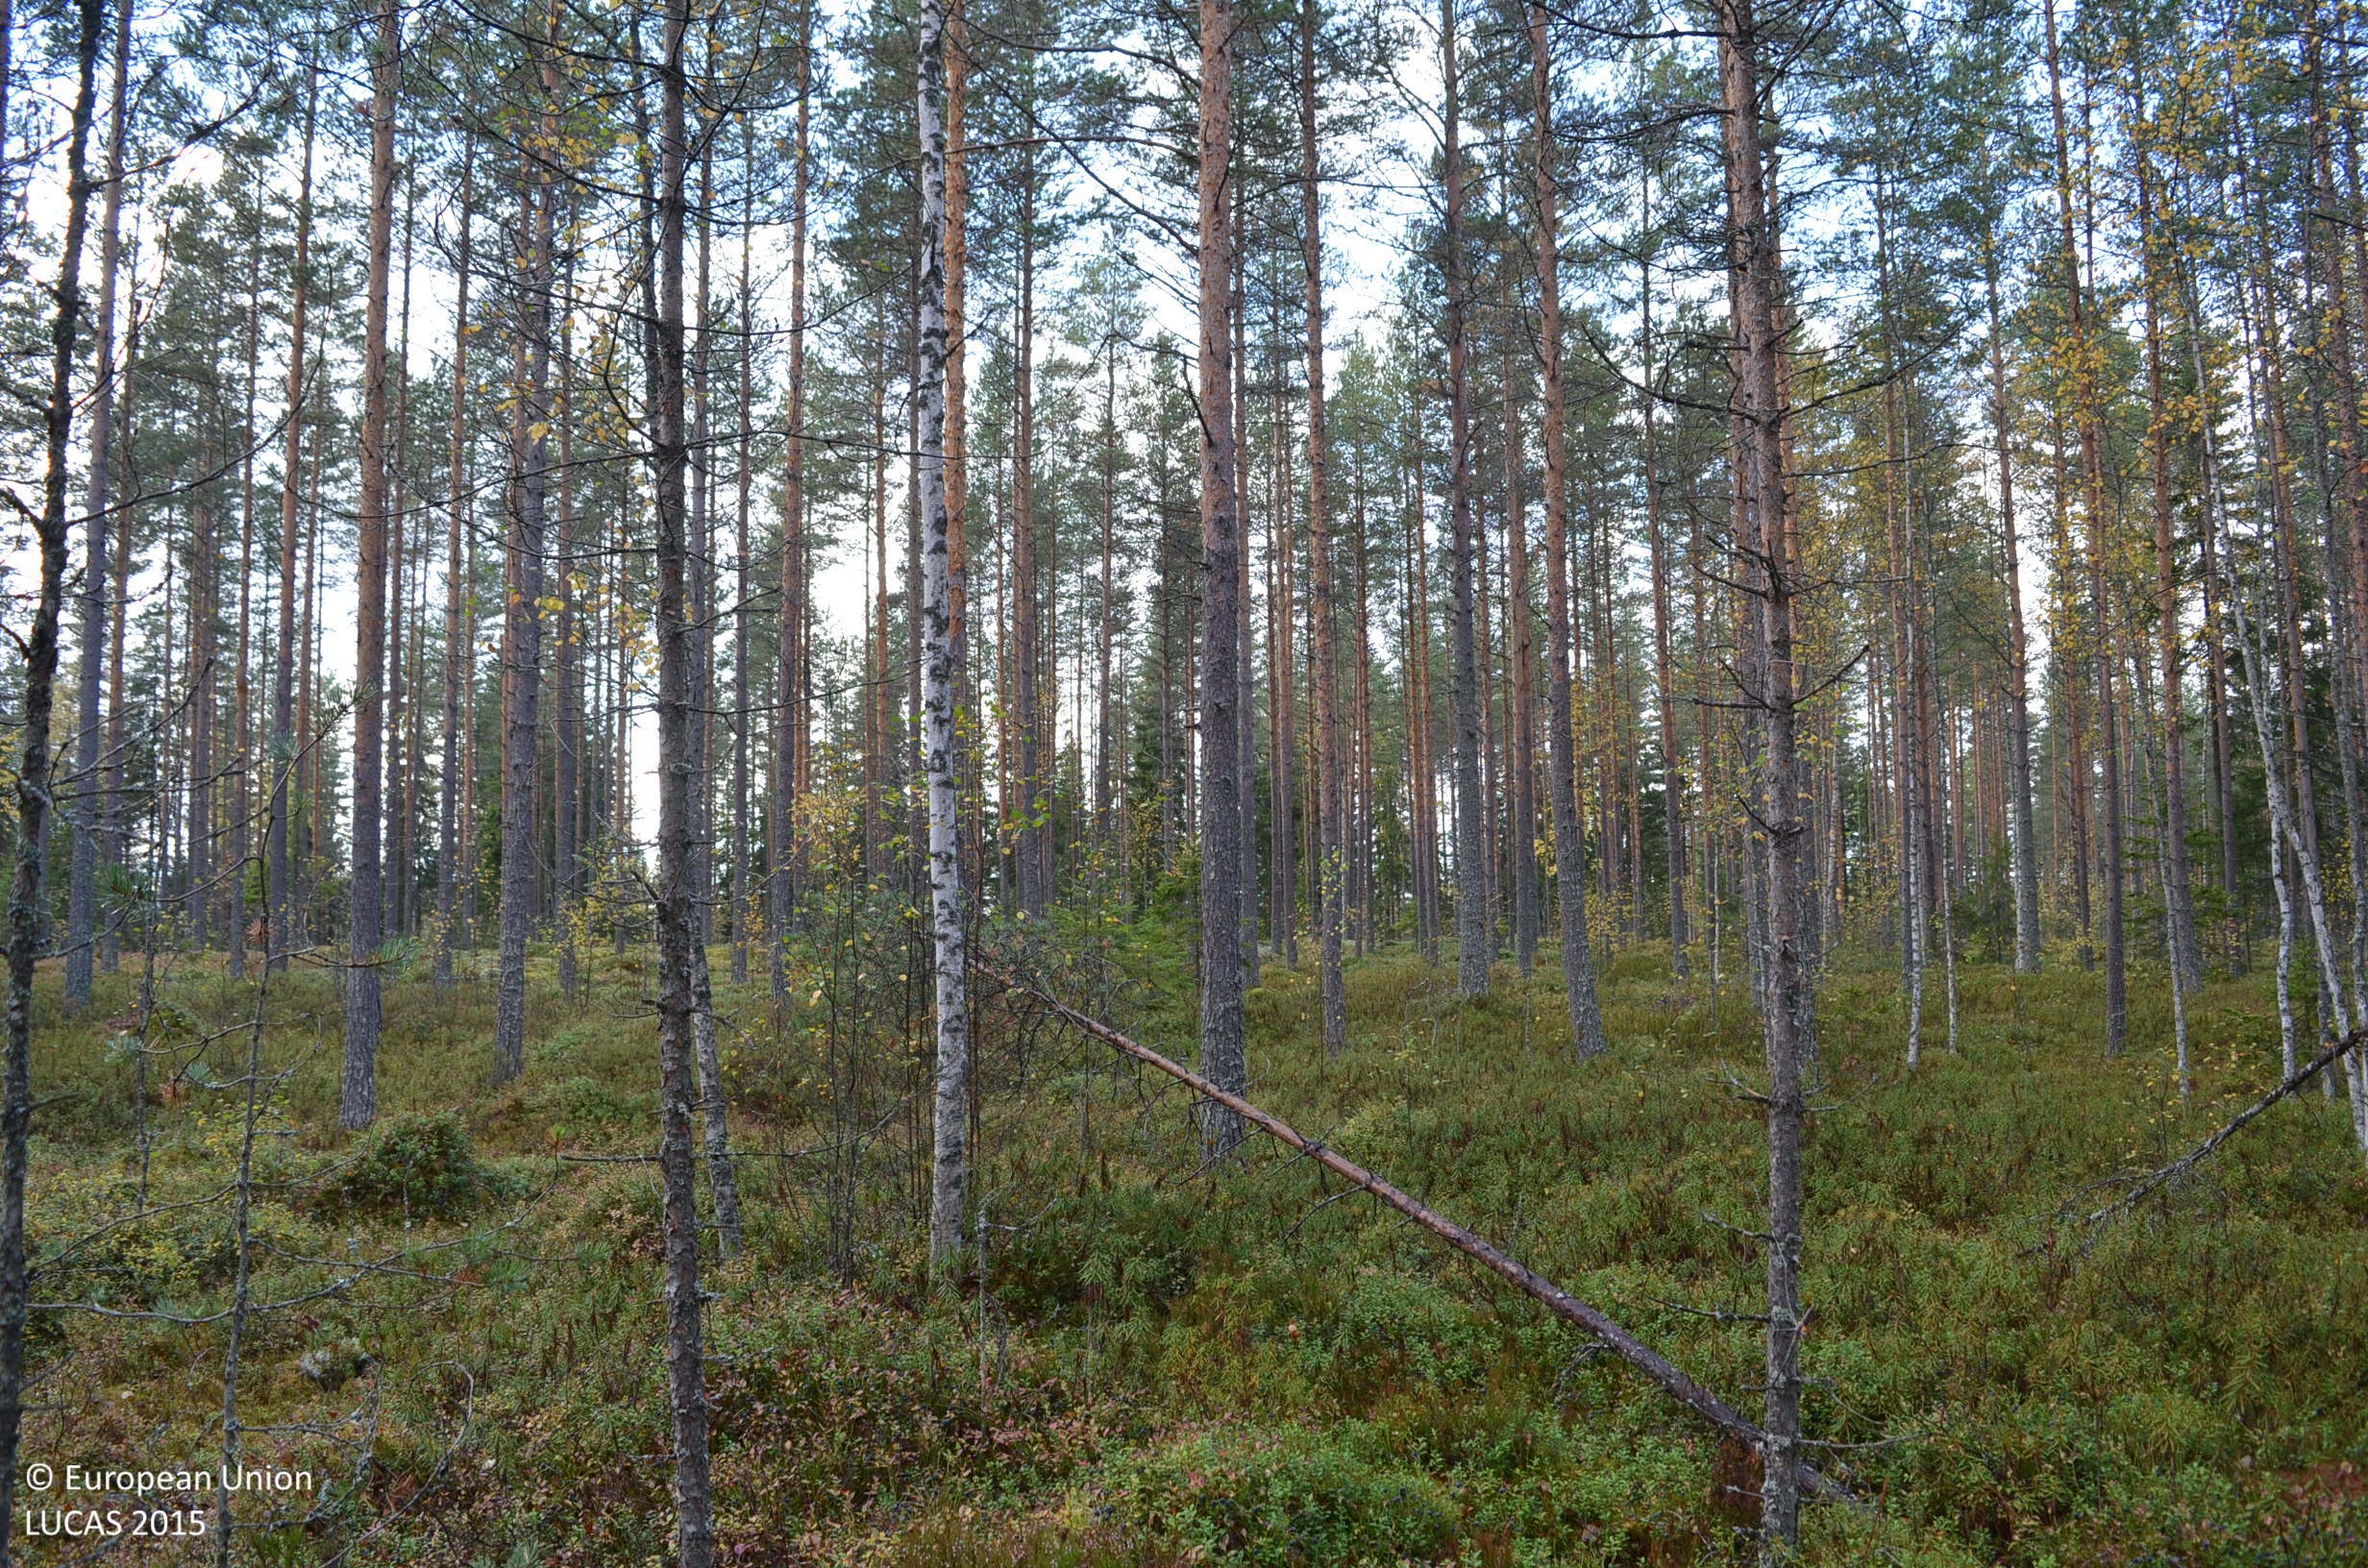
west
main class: Woodland
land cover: Pine dominated coniferous woodland
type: boreal forest
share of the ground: 50 - 75 %
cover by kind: coniferous forest trees 65 %, shrubs 30 %, broadleaved forest trees 5 %
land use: Forestry
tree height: > 5 m
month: September
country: FI
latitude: 62.4519
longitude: 23.5817
